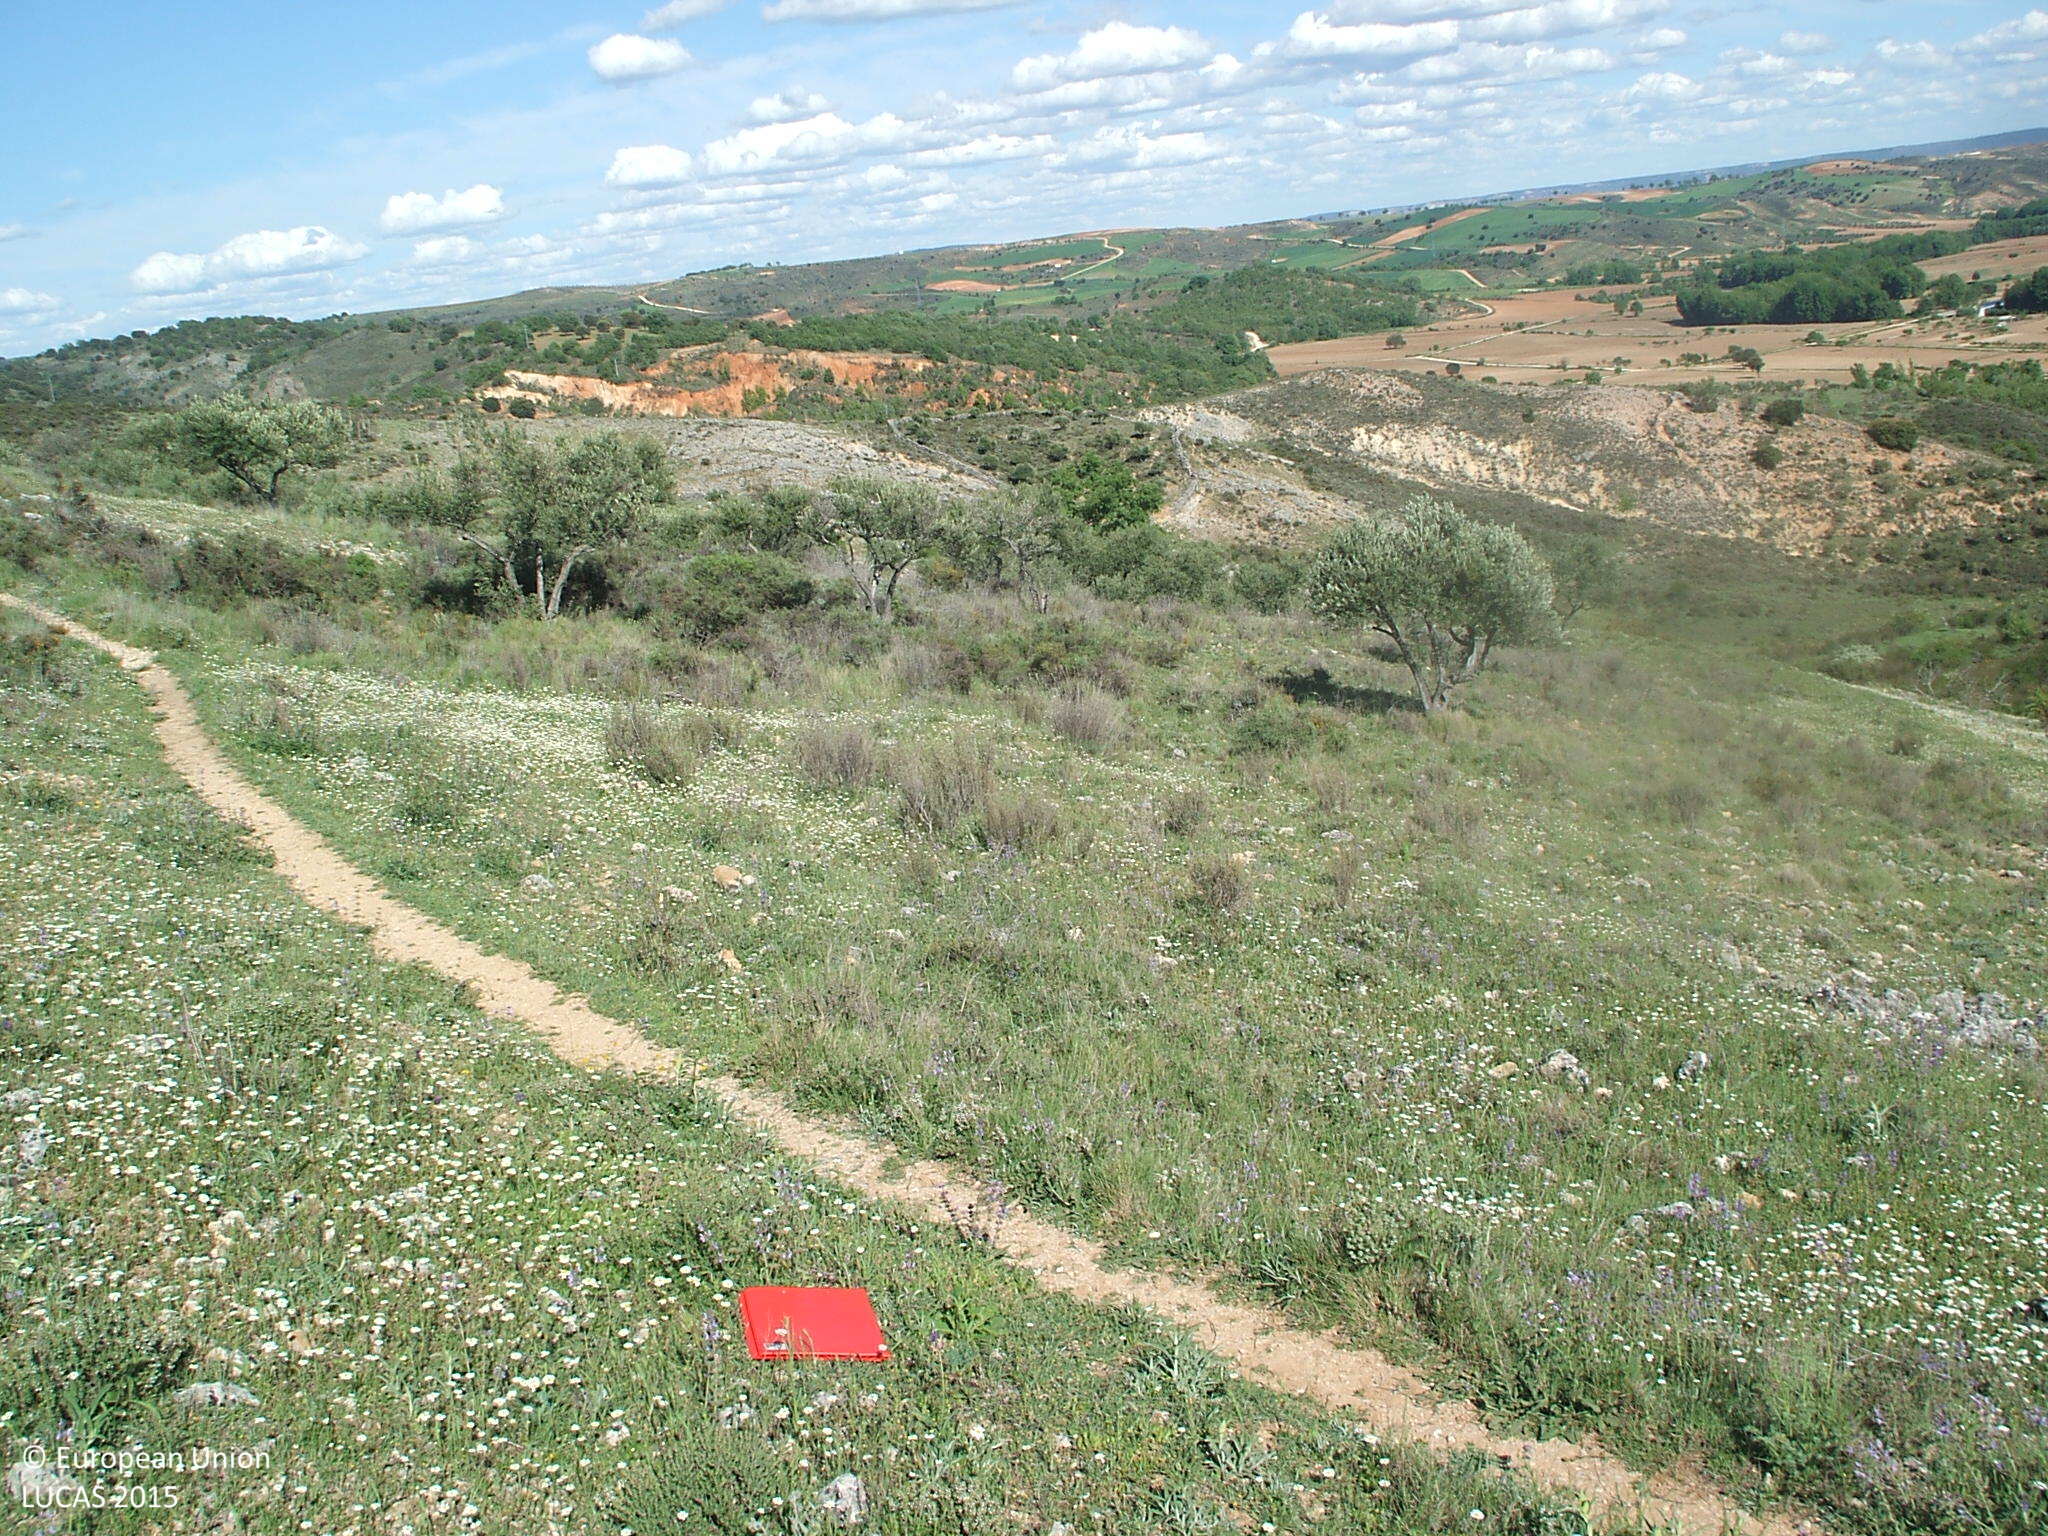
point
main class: Shrubland
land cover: Shrubland without tree cover
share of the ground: 25 - 50 %
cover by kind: herbaceous plants 60 %, shrubs 40 %
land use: Semi-natural and natural areas not in use
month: May
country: ES
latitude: 41.0040
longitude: -3.0311
